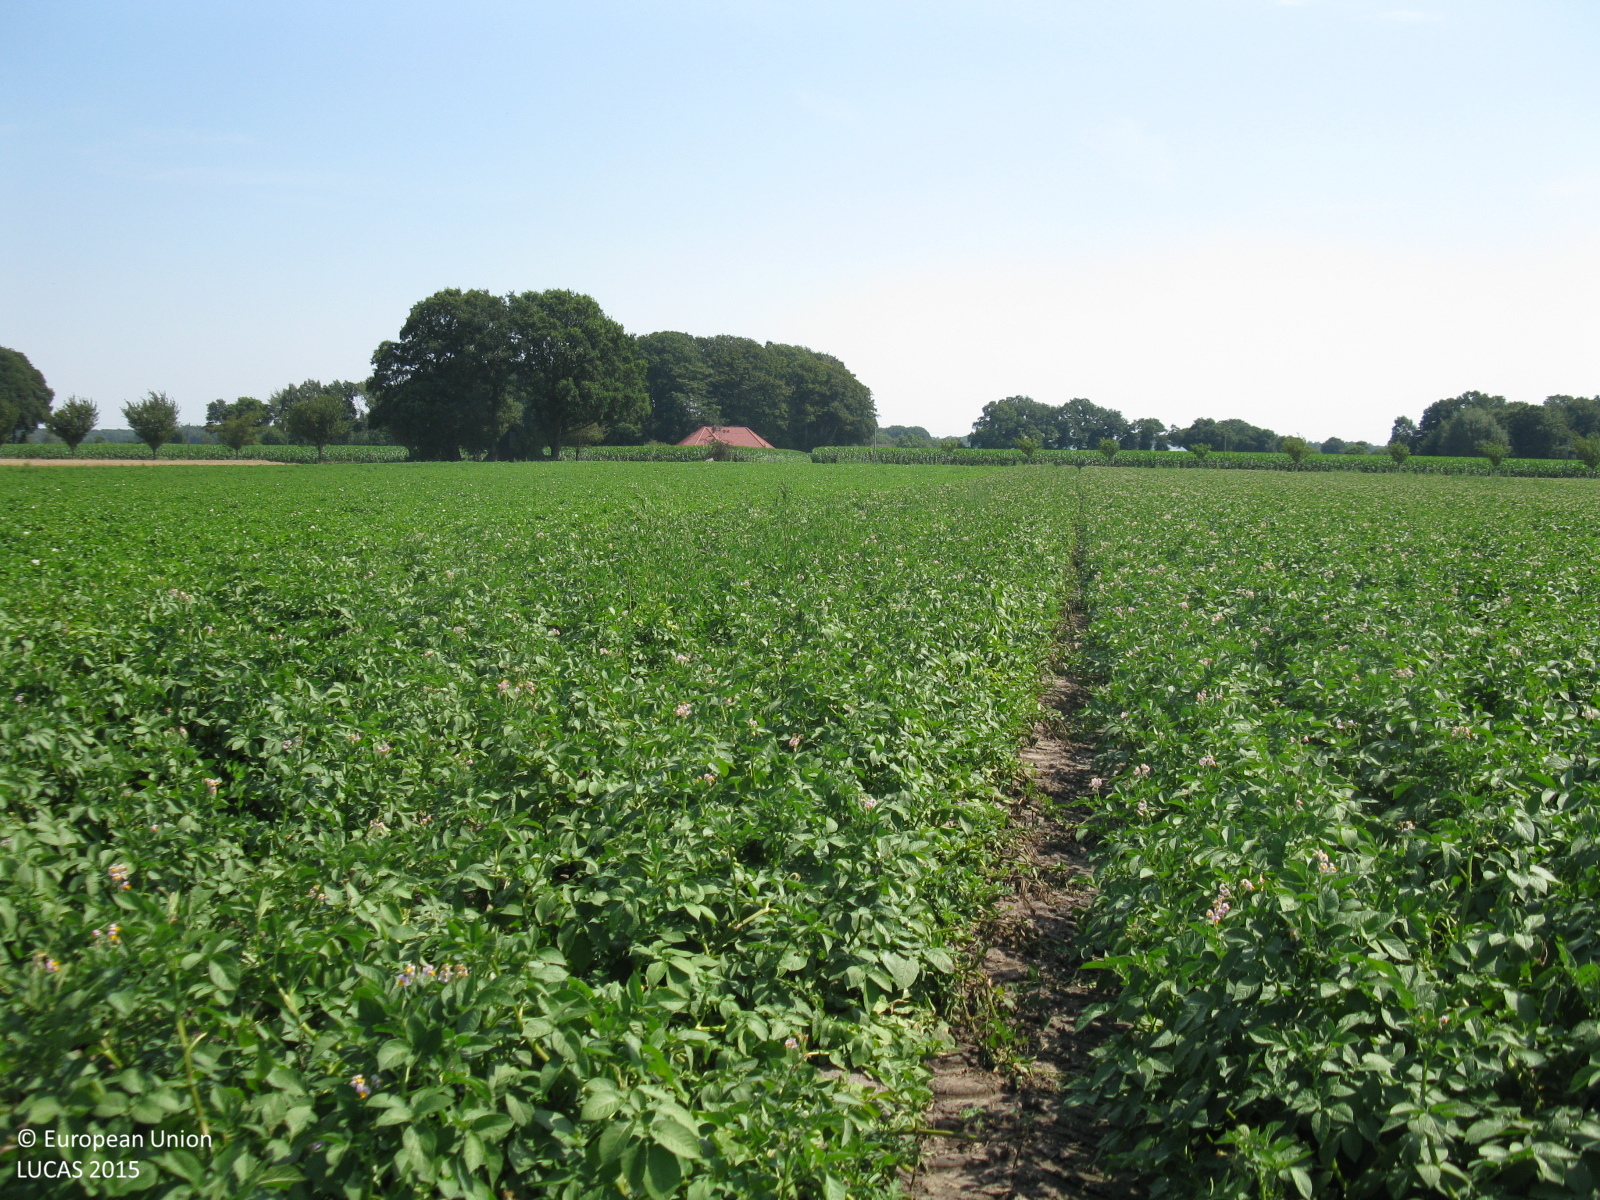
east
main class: Cropland
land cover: Potatoes
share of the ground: > 75 %
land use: Agriculture (excluding fallow land and kitchen gardens)
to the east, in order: Potatoes; Grass margins; Paved roads, cycling and walking lanes; Grass margins; Electric lines; Lines of trees; Maize
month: August
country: DE
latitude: 52.9788
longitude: 8.4665
